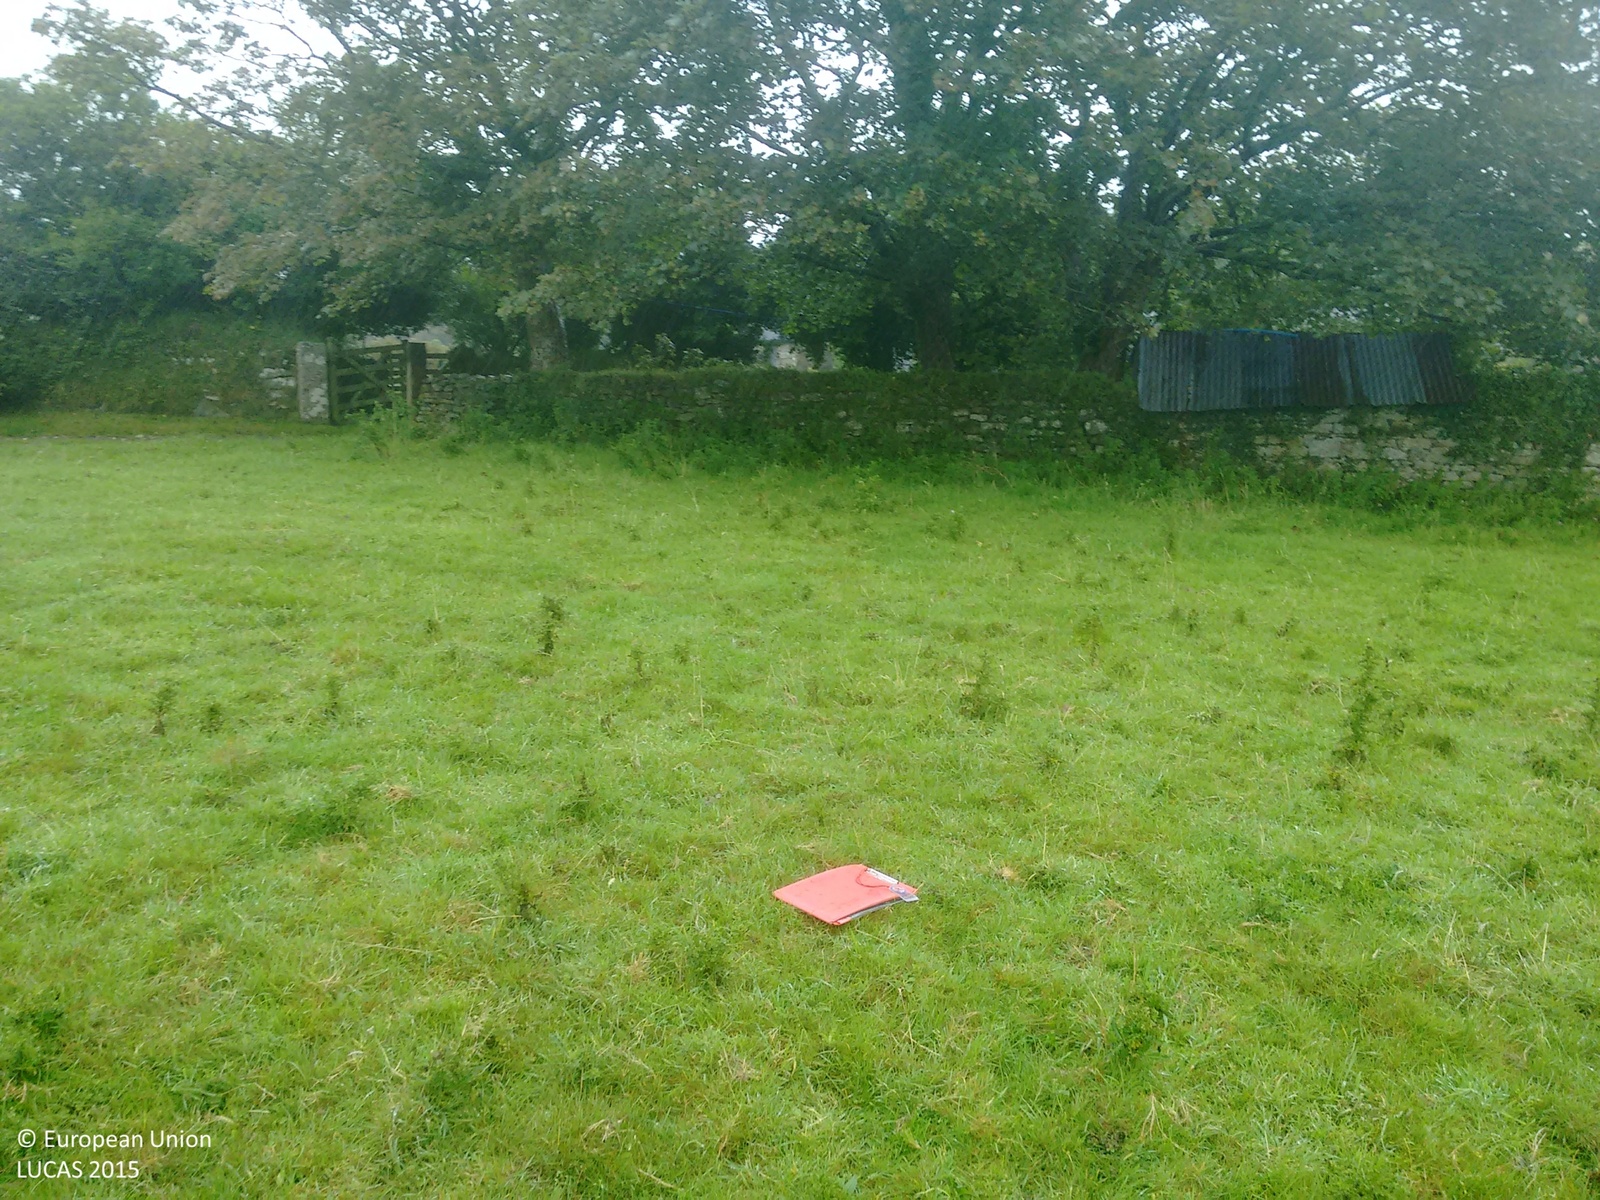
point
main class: Grassland
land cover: Grassland without tree/shrub cover
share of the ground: > 75 %
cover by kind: herbaceous plants 100 %
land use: Agriculture (excluding fallow land and kitchen gardens)
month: August
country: GB
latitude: 50.1255
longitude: -5.2131
